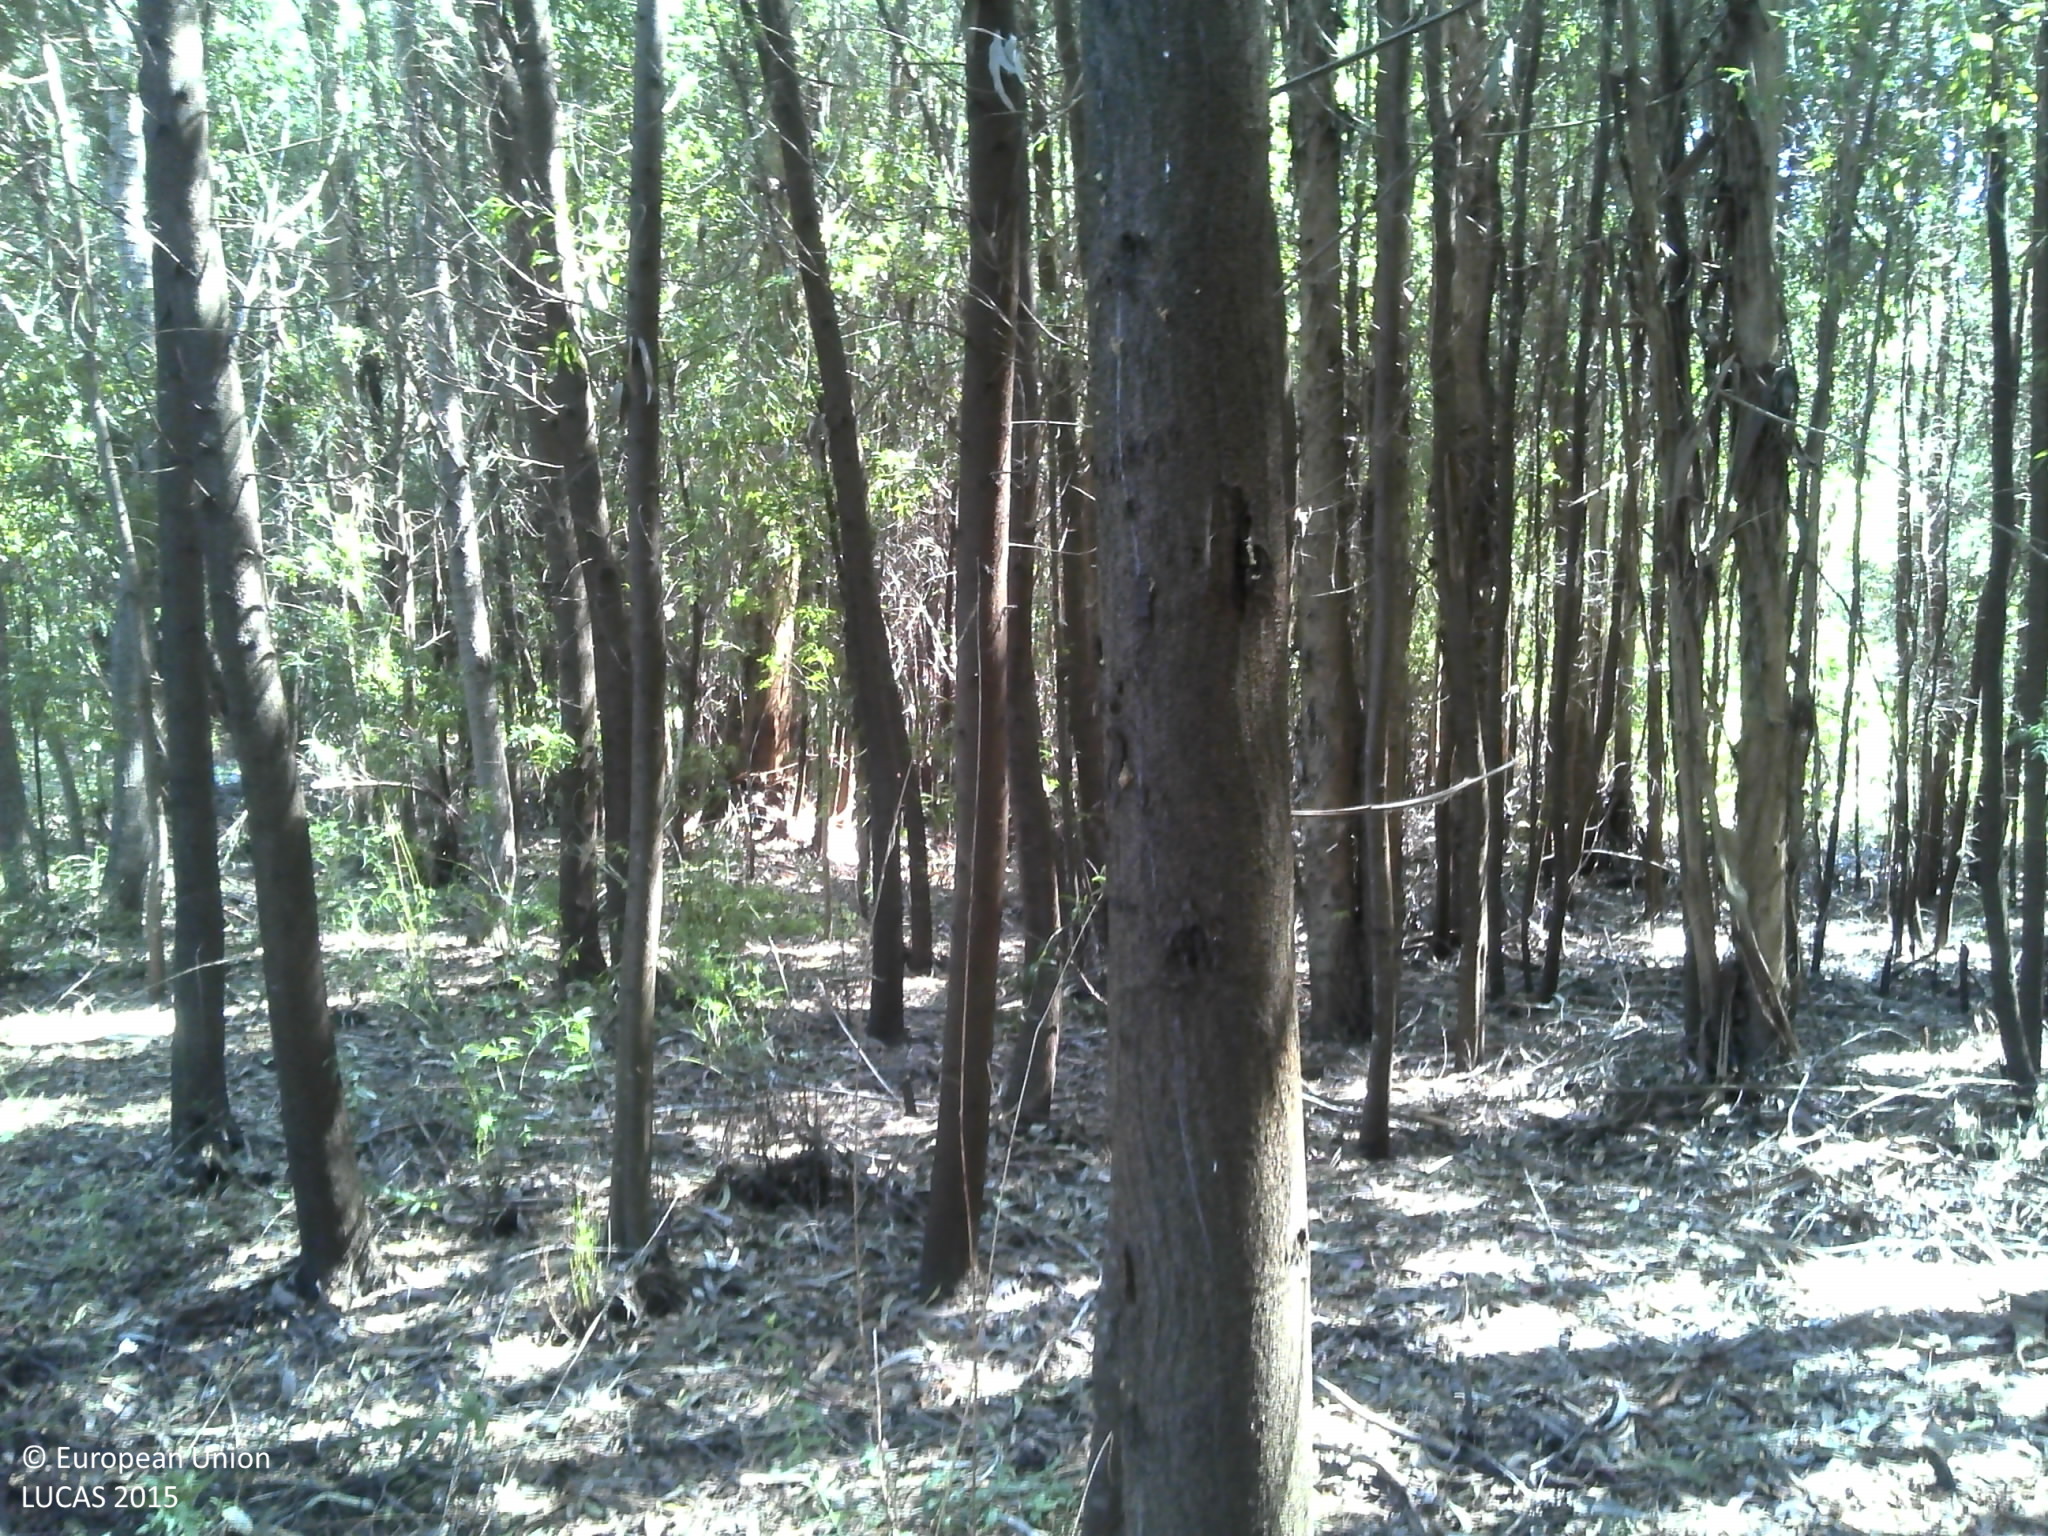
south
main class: Woodland
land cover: Broadleaved woodland
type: exotic forest
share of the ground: 50 - 75 %
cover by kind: broadleaved forest trees 75 %, shrubs 10 %, unconsolidated bare surface 10 %, herbaceous plants 5 %
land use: Forestry
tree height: > 5 m
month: May
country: PT
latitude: 40.4604
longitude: -8.7415
